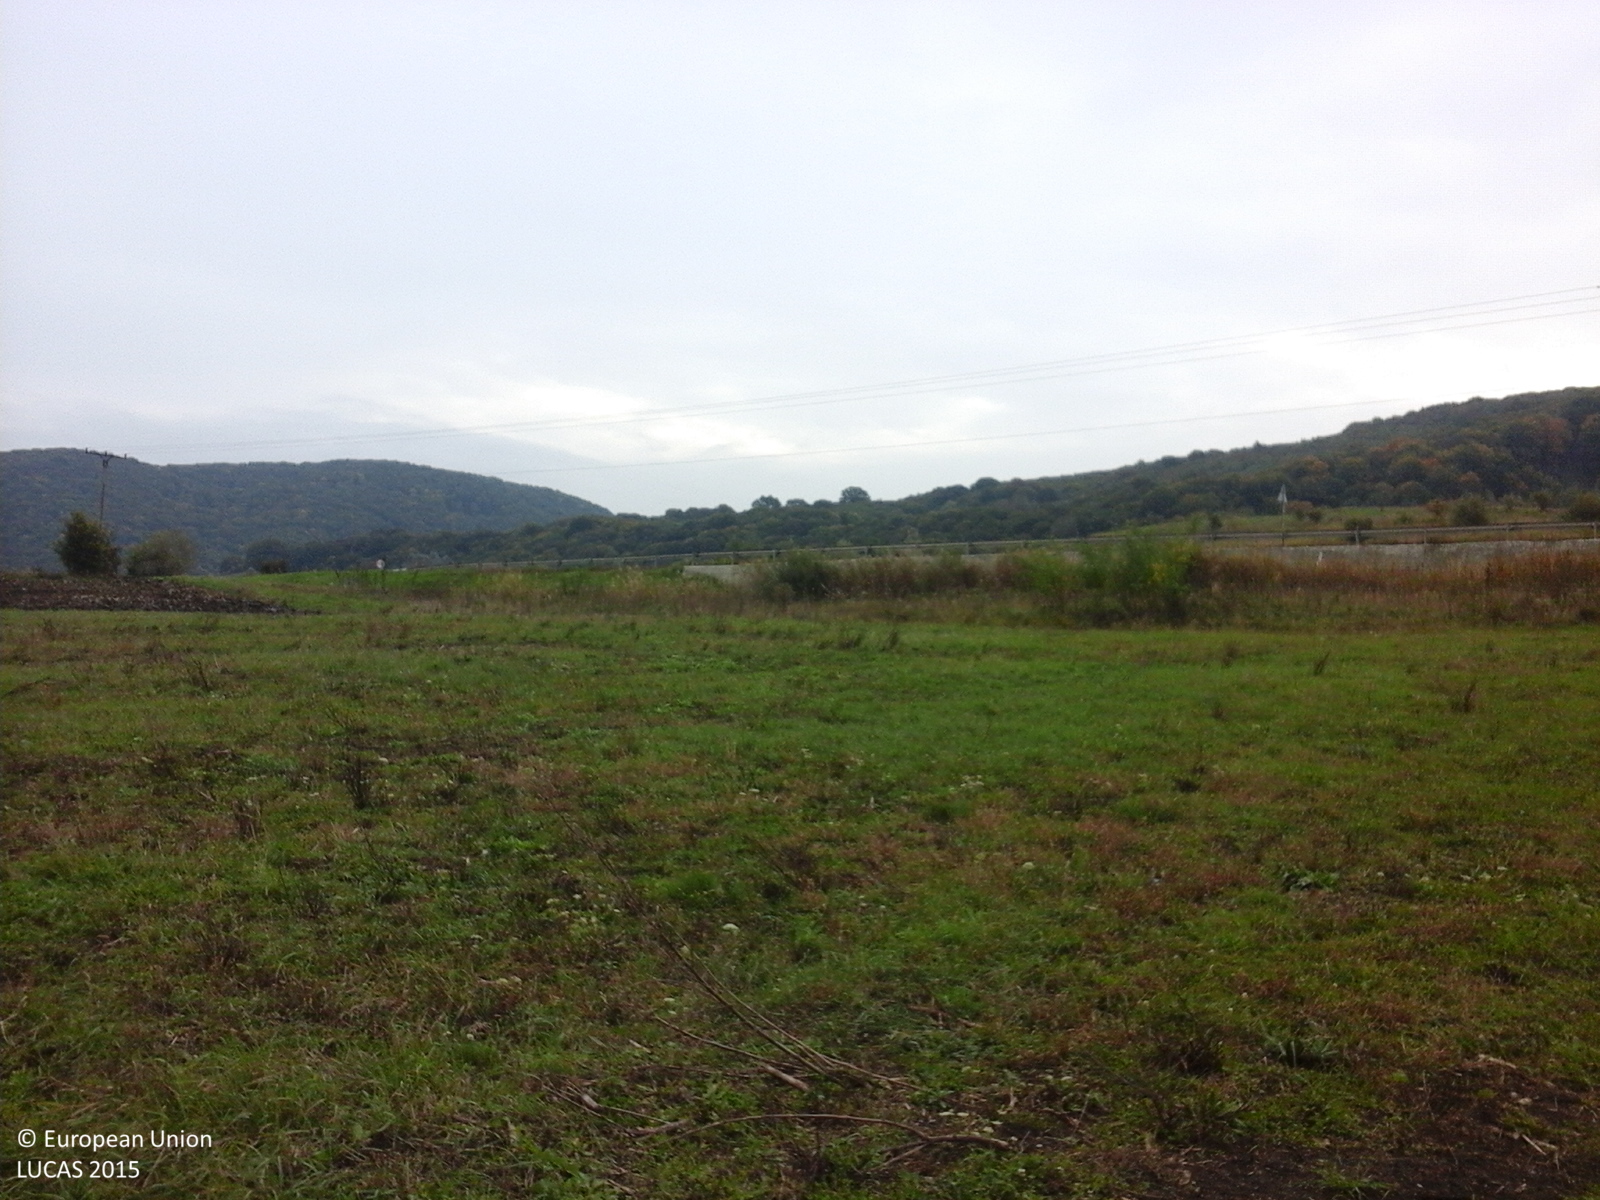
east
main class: Grassland
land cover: Grassland without tree/shrub cover
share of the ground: > 75 %
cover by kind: herbaceous plants 100 %
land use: Agriculture (excluding fallow land and kitchen gardens)
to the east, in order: Grassland without tree/shrub cover; Electric lines; Spontaneously vegetated surfaces; Ditches and canals; Artificial constructions; Paved roads, cycling and walking lanes; Ditches and canals; Spontaneously vegetated surfaces; Tracks; Spontaneously vegetated surfaces; Other bare soil; Abandoned hedges; Tracks; Grassland without tree/shrub cover
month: October
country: RO
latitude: 46.1433
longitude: 25.0219
